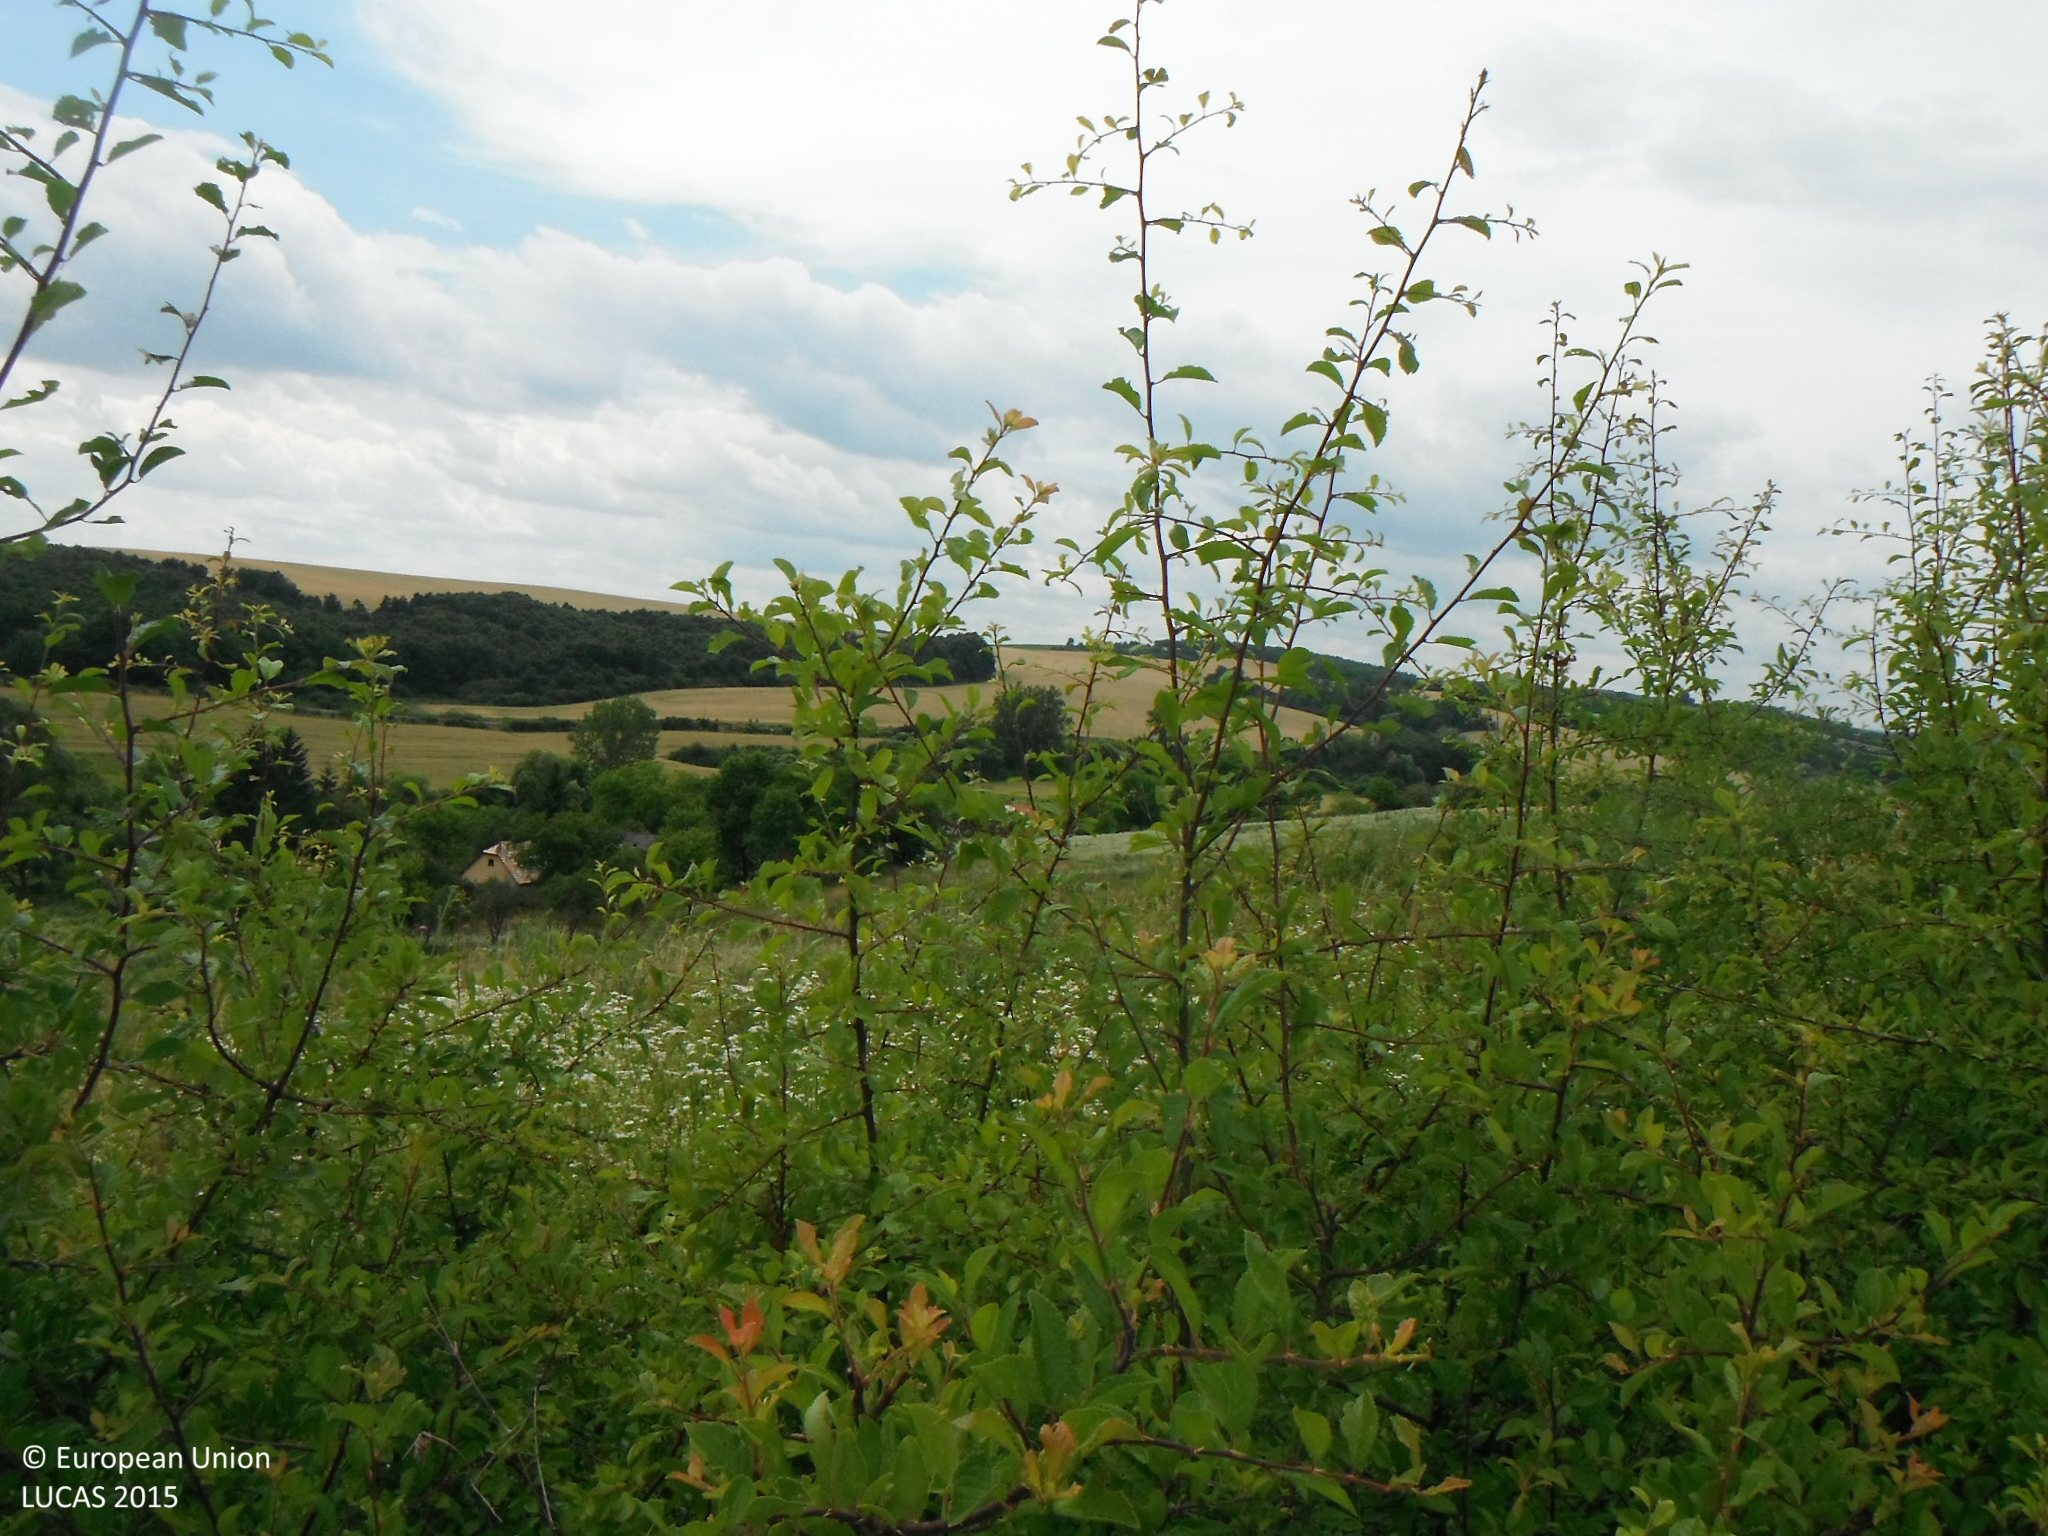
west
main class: Shrubland
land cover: Shrubland without tree cover
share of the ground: > 75 %
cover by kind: shrubs 90 %, herbaceous plants 10 %
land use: Semi-natural and natural areas not in use
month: June
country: SK
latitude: 48.1410
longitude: 19.4713
